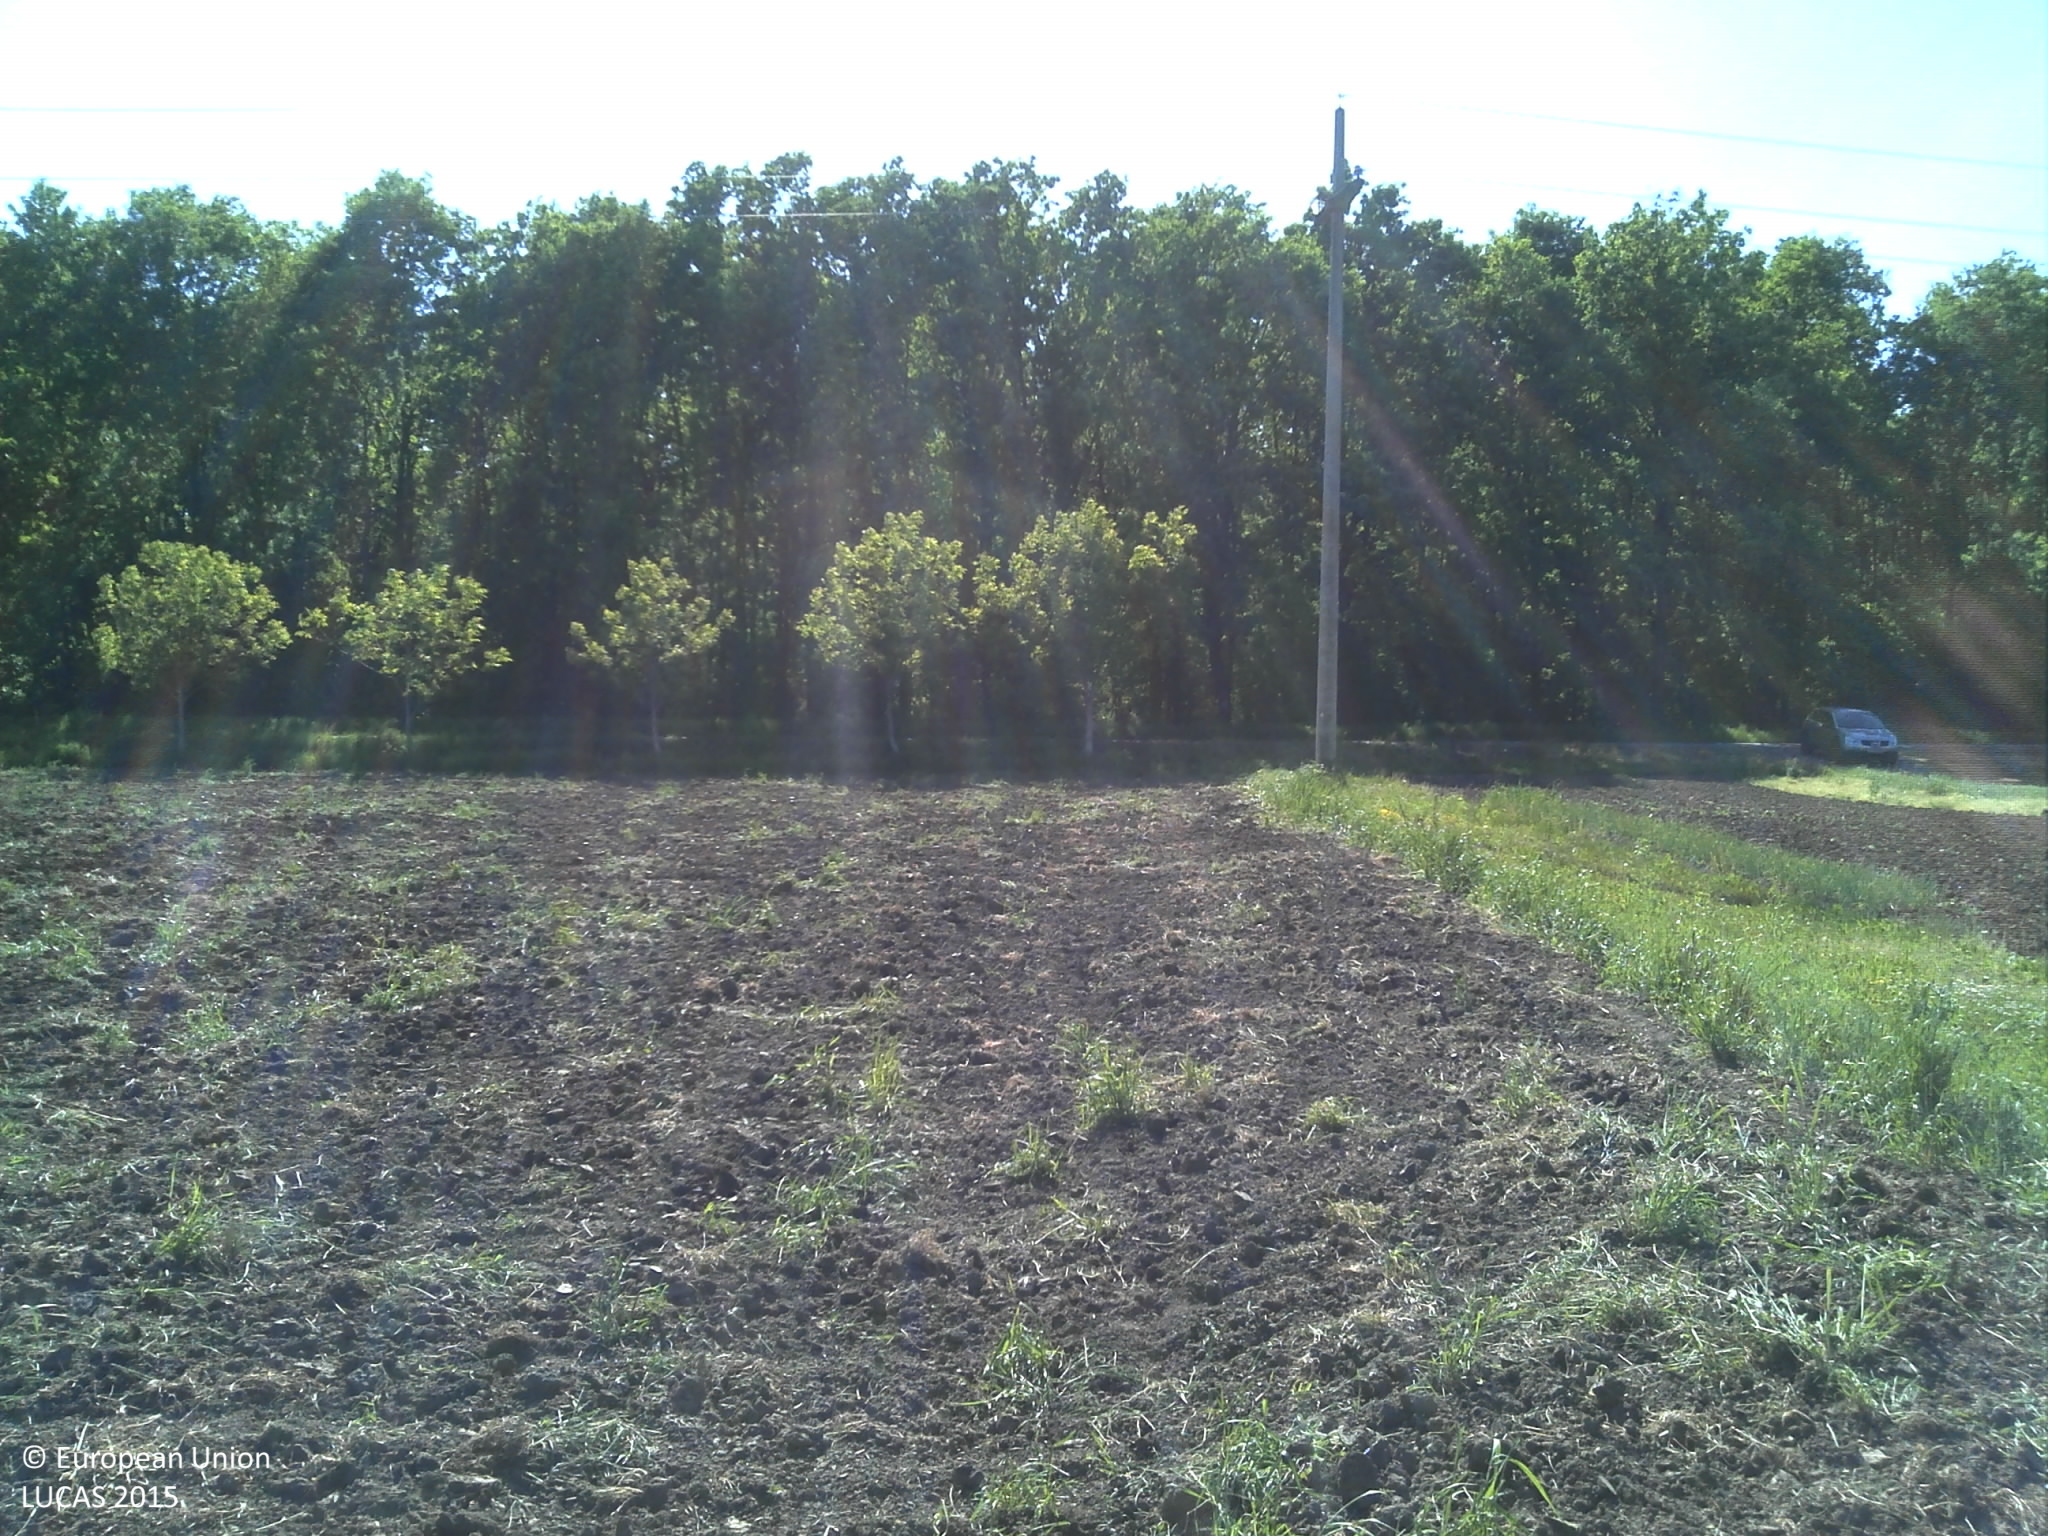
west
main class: Grassland
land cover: Spontaneously vegetated surfaces
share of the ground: < 10 %
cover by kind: unconsolidated bare surface 90 %, herbaceous plants 10 %
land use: Fallow land
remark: Harvested field
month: May
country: HR
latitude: 45.1522
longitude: 18.1563
